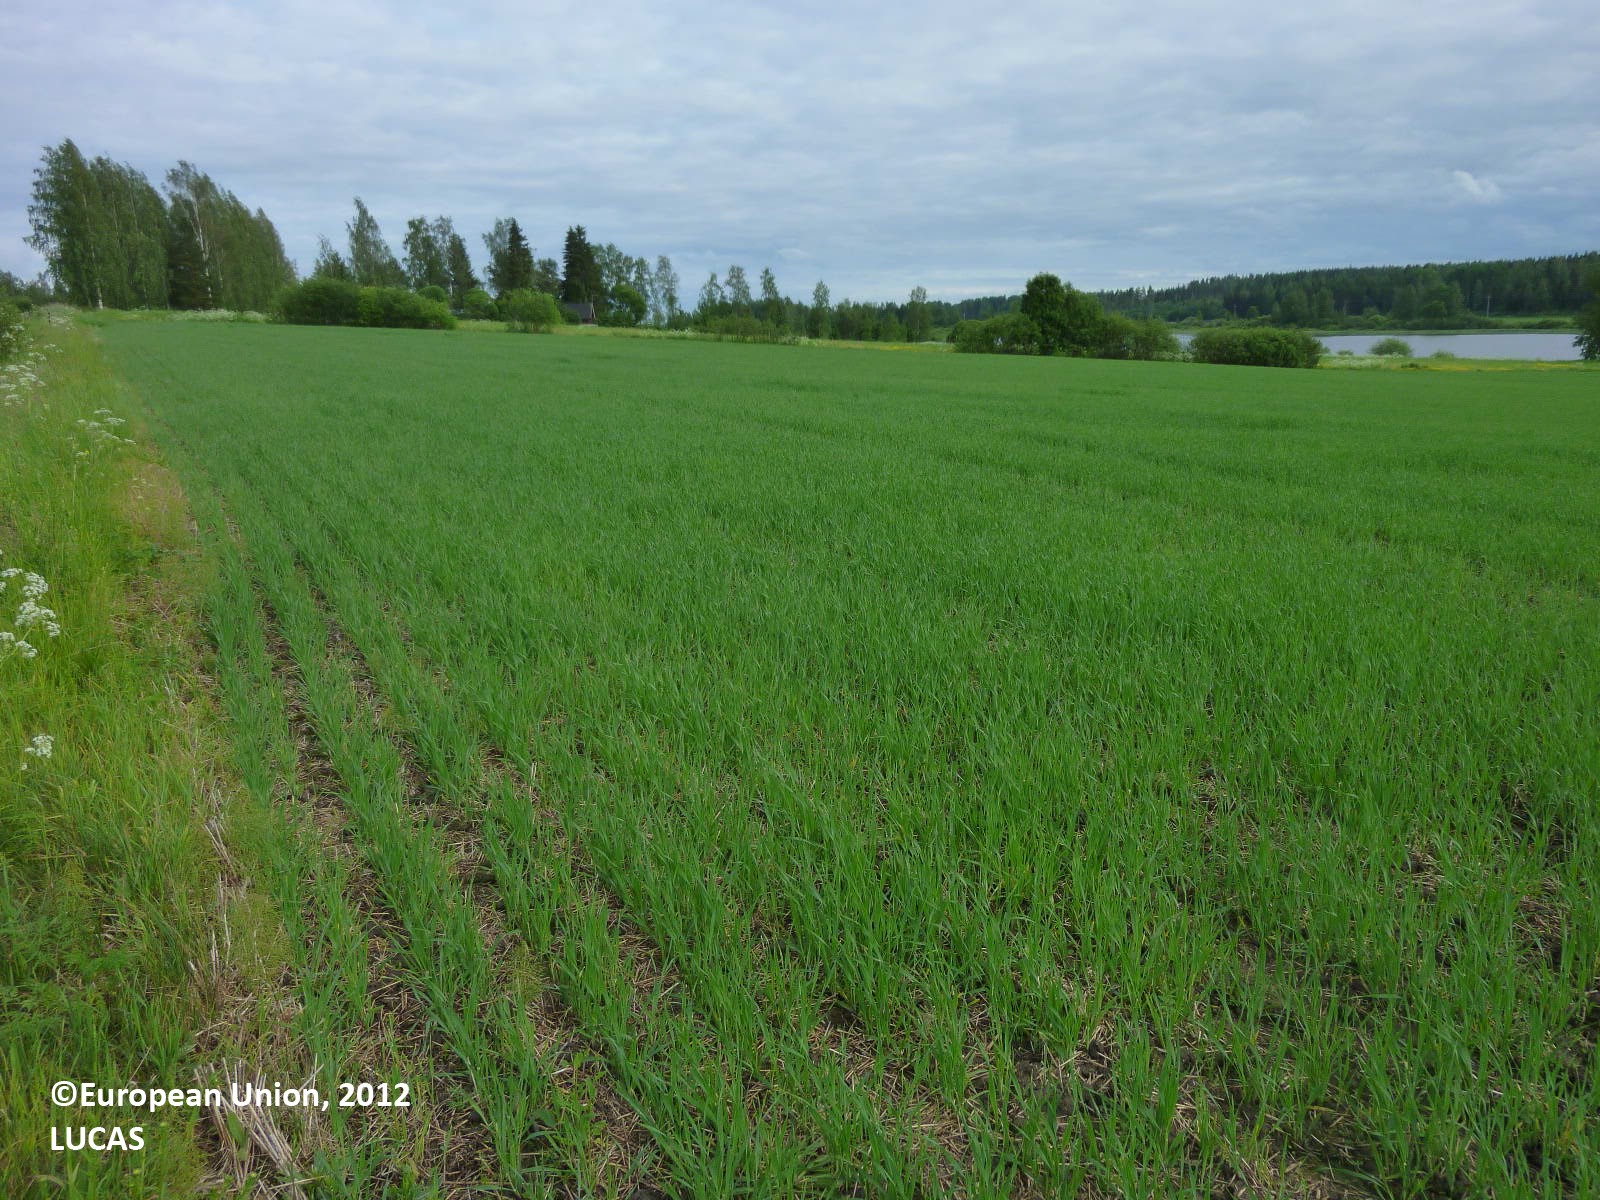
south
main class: Cropland
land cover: Barley
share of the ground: 50 - 75 %
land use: Agriculture (excluding fallow land and kitchen gardens)
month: June
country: FI
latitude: 61.6322
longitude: 22.4956
